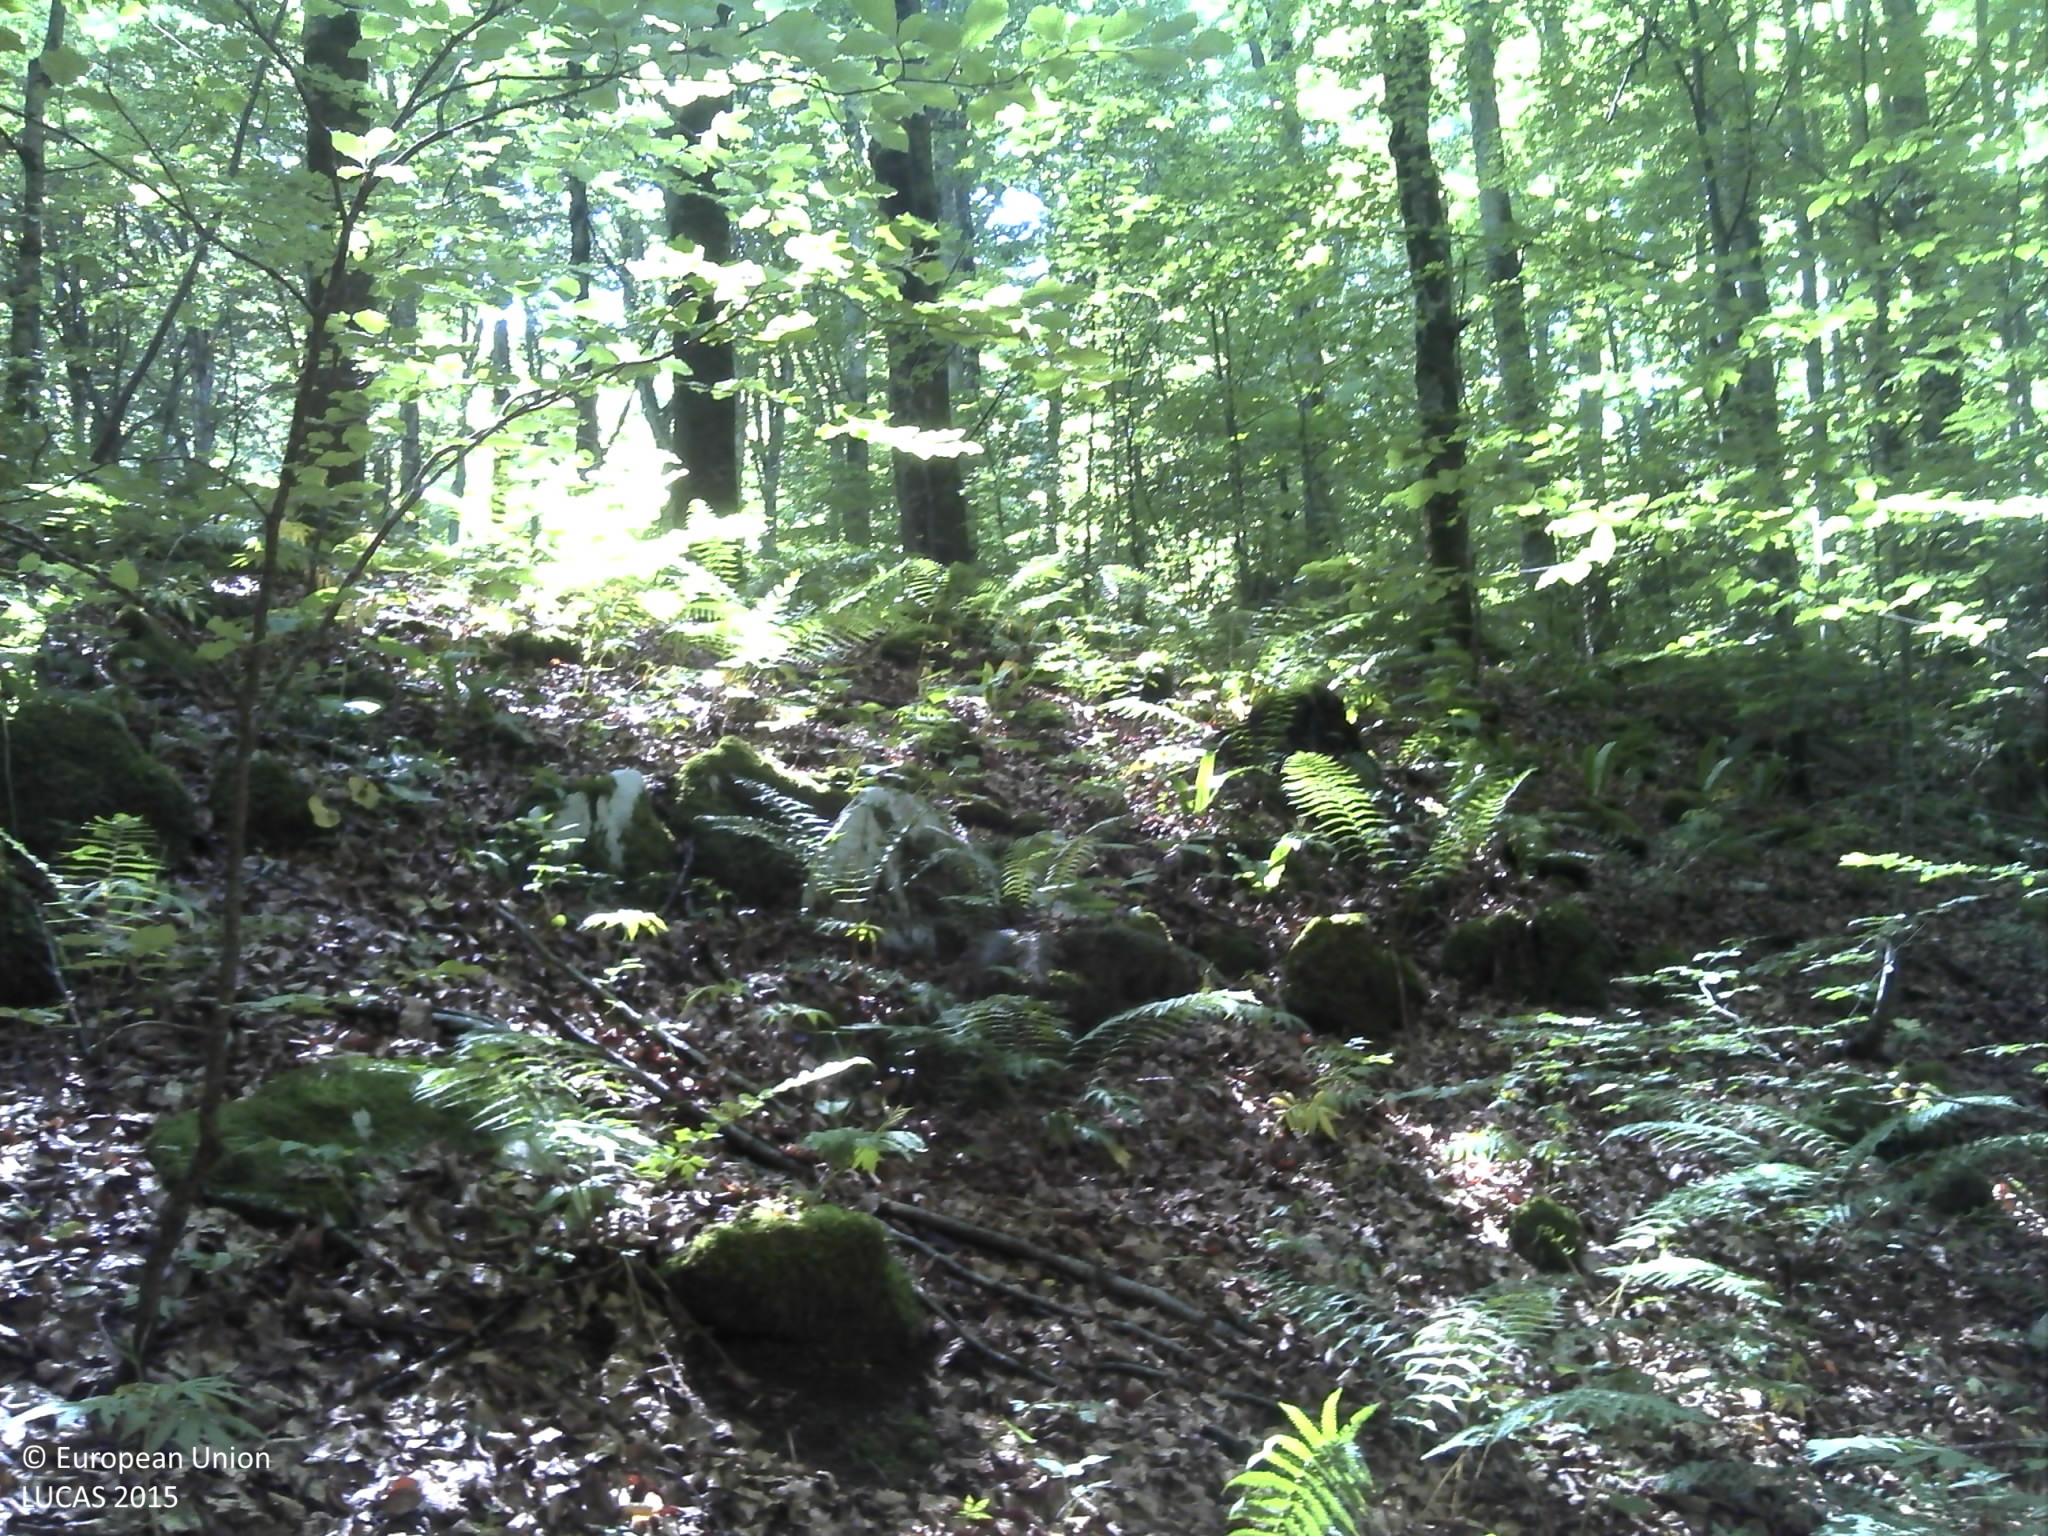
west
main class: Woodland
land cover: Broadleaved woodland
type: beech forest
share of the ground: > 75 %
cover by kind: broadleaved forest trees 95 %, consolidated bare surface 5 %
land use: Forestry
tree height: > 5 m
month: June
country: HR
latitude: 44.8845
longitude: 15.6285
